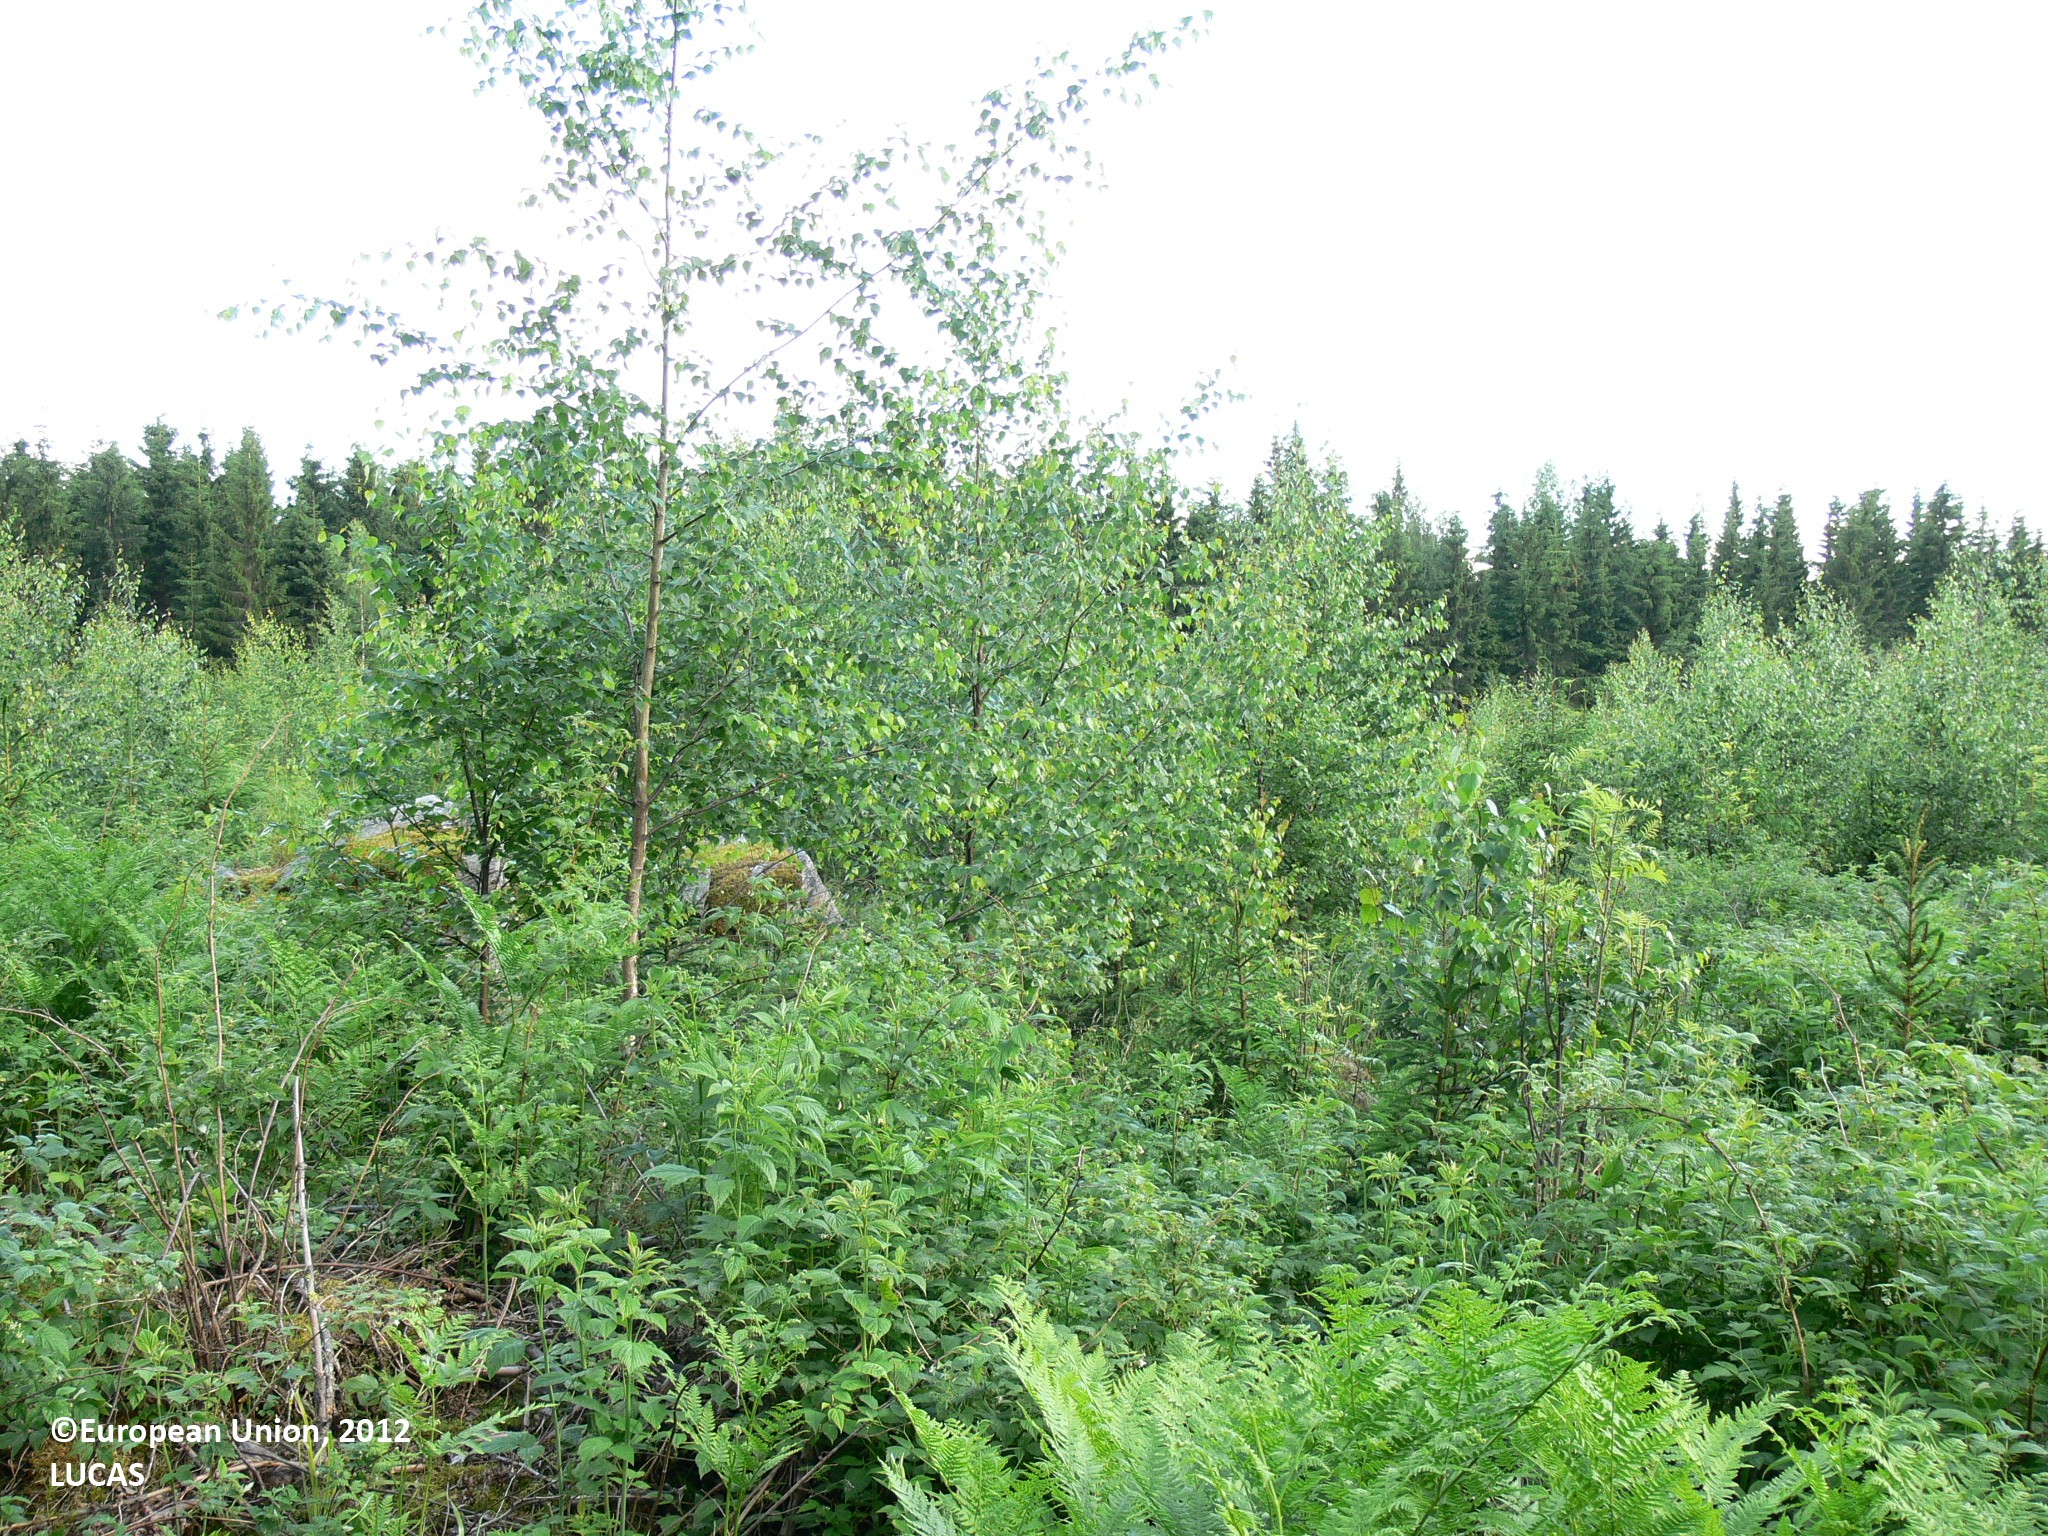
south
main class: Woodland
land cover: Spruce dominated mixed woodland
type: boreal forest
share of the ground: 25 - 50 %
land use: Forestry
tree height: < 5 m
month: June
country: FI
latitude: 62.3617
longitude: 29.5066
